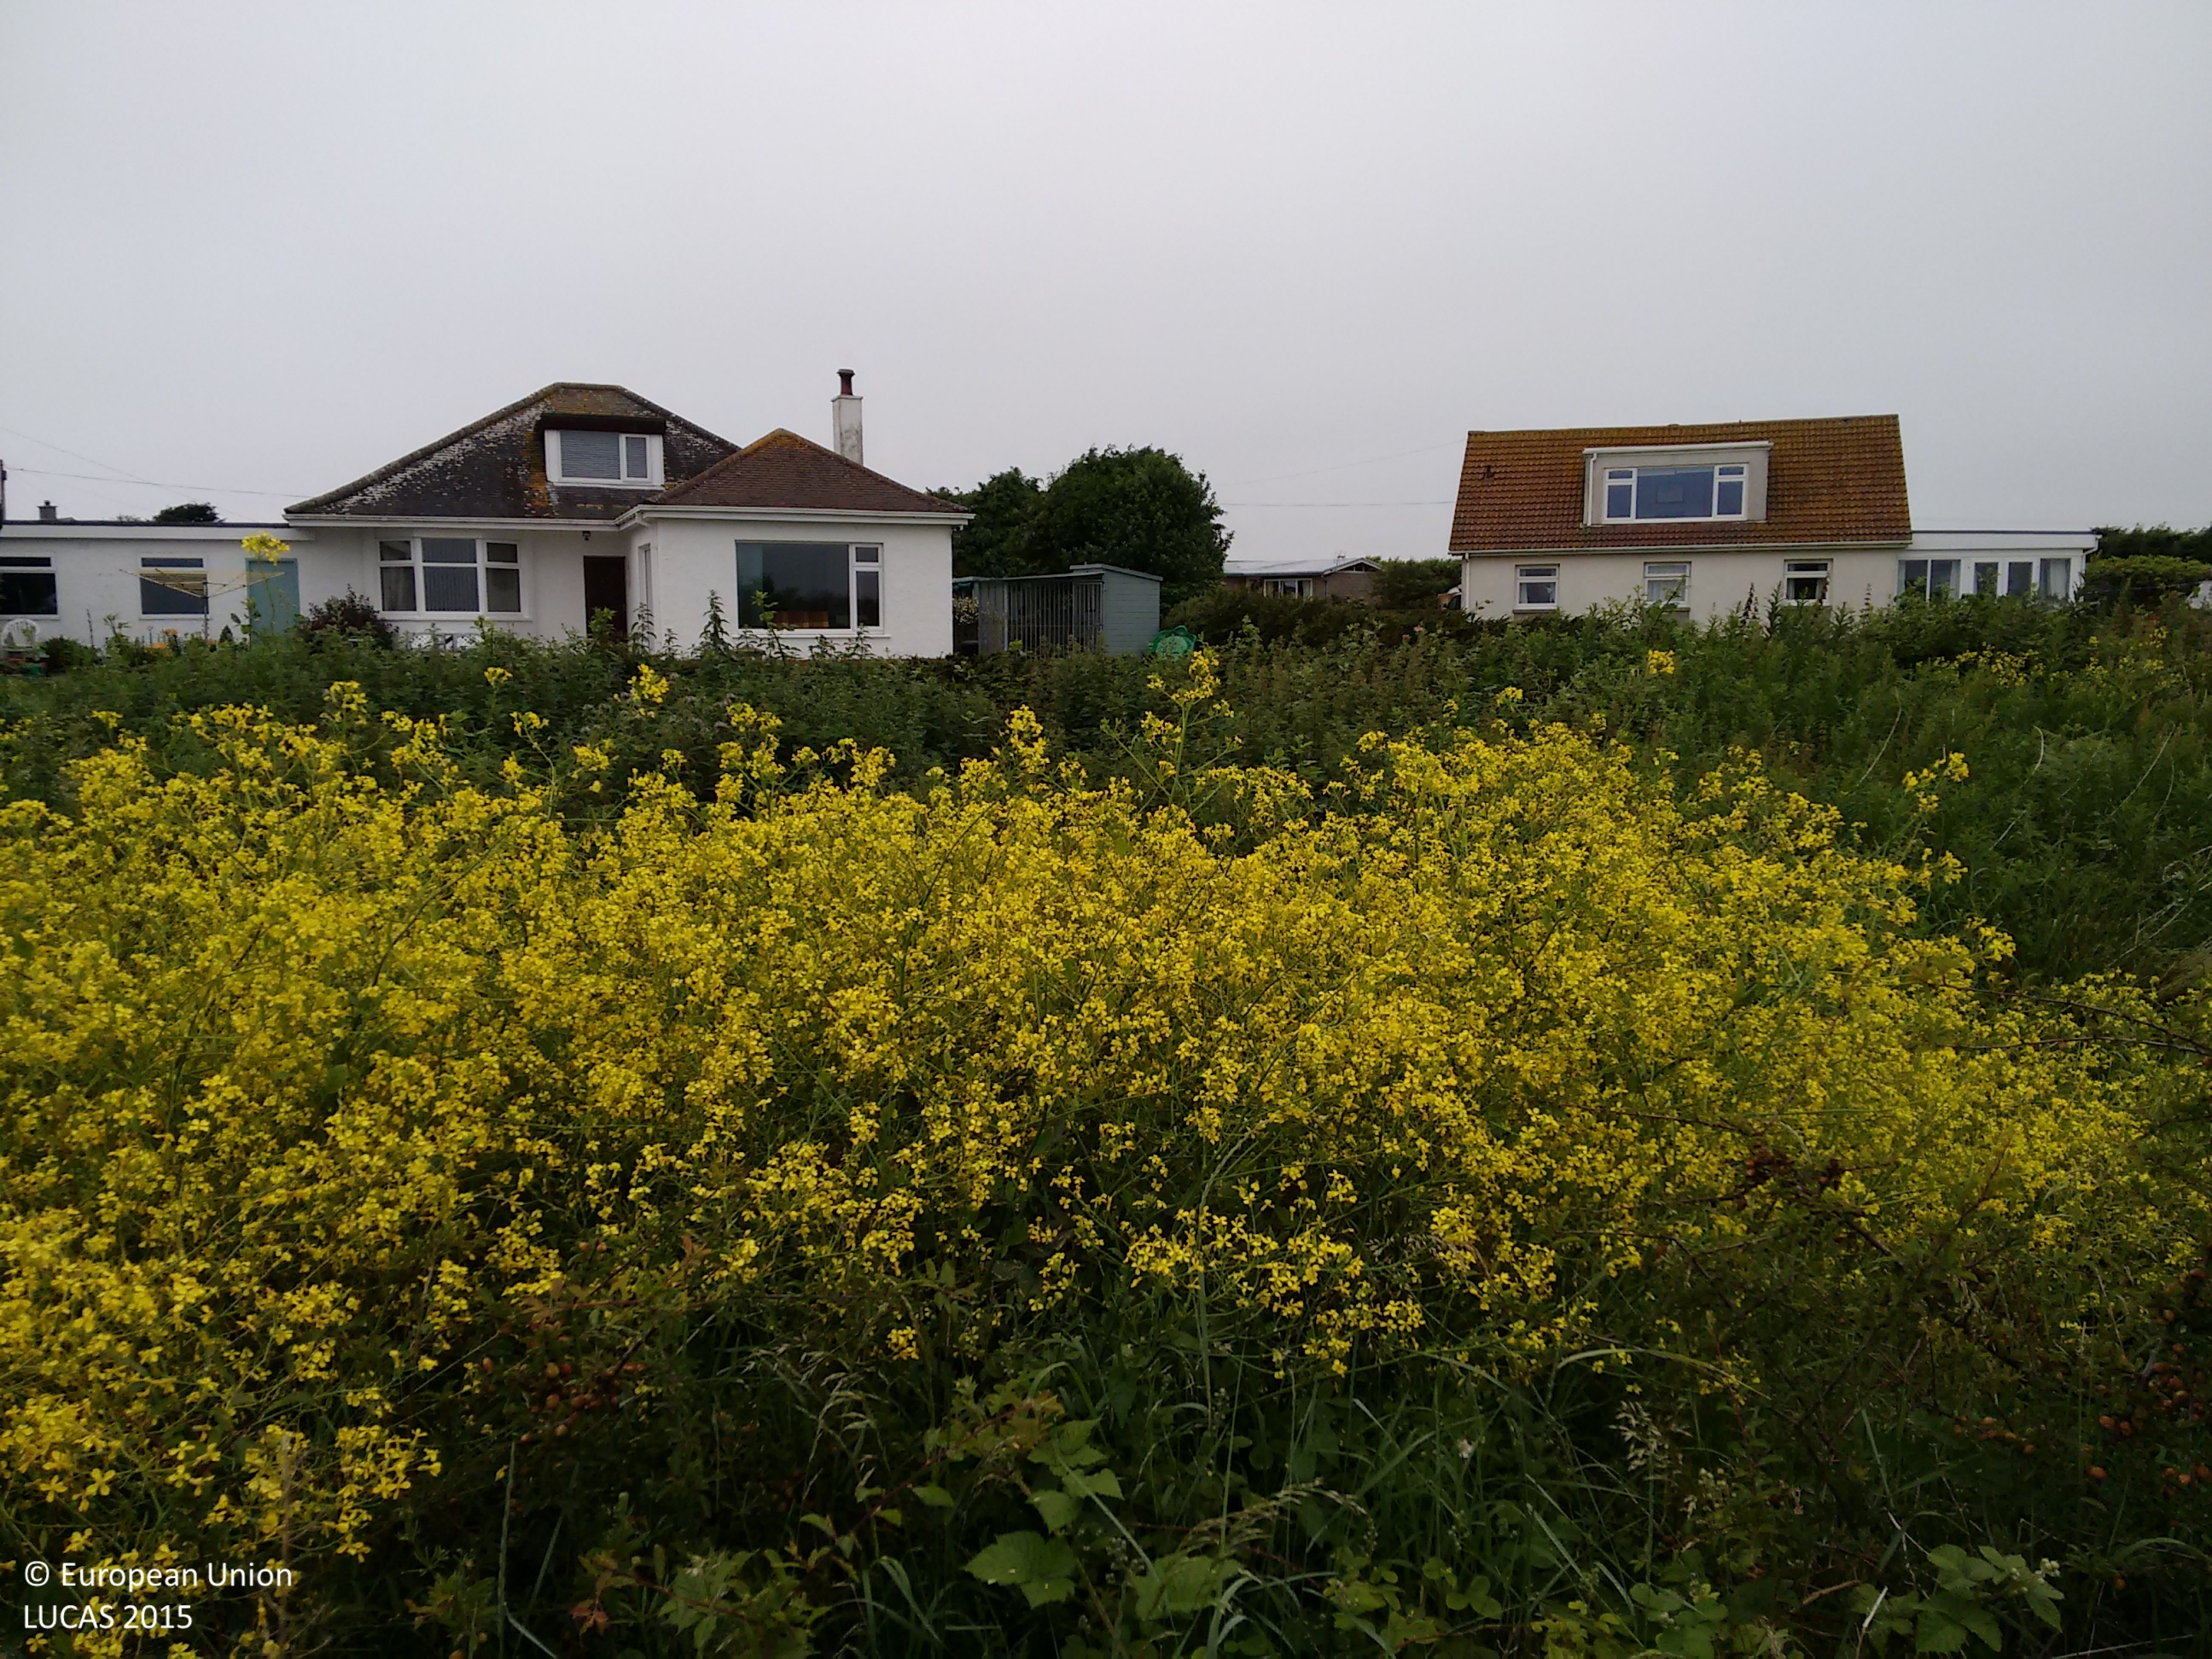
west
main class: Grassland
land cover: Grassland without tree/shrub cover
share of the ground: > 75 %
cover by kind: herbaceous plants 100 %
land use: Residential
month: July
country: GB
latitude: 54.8754
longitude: -3.5947
